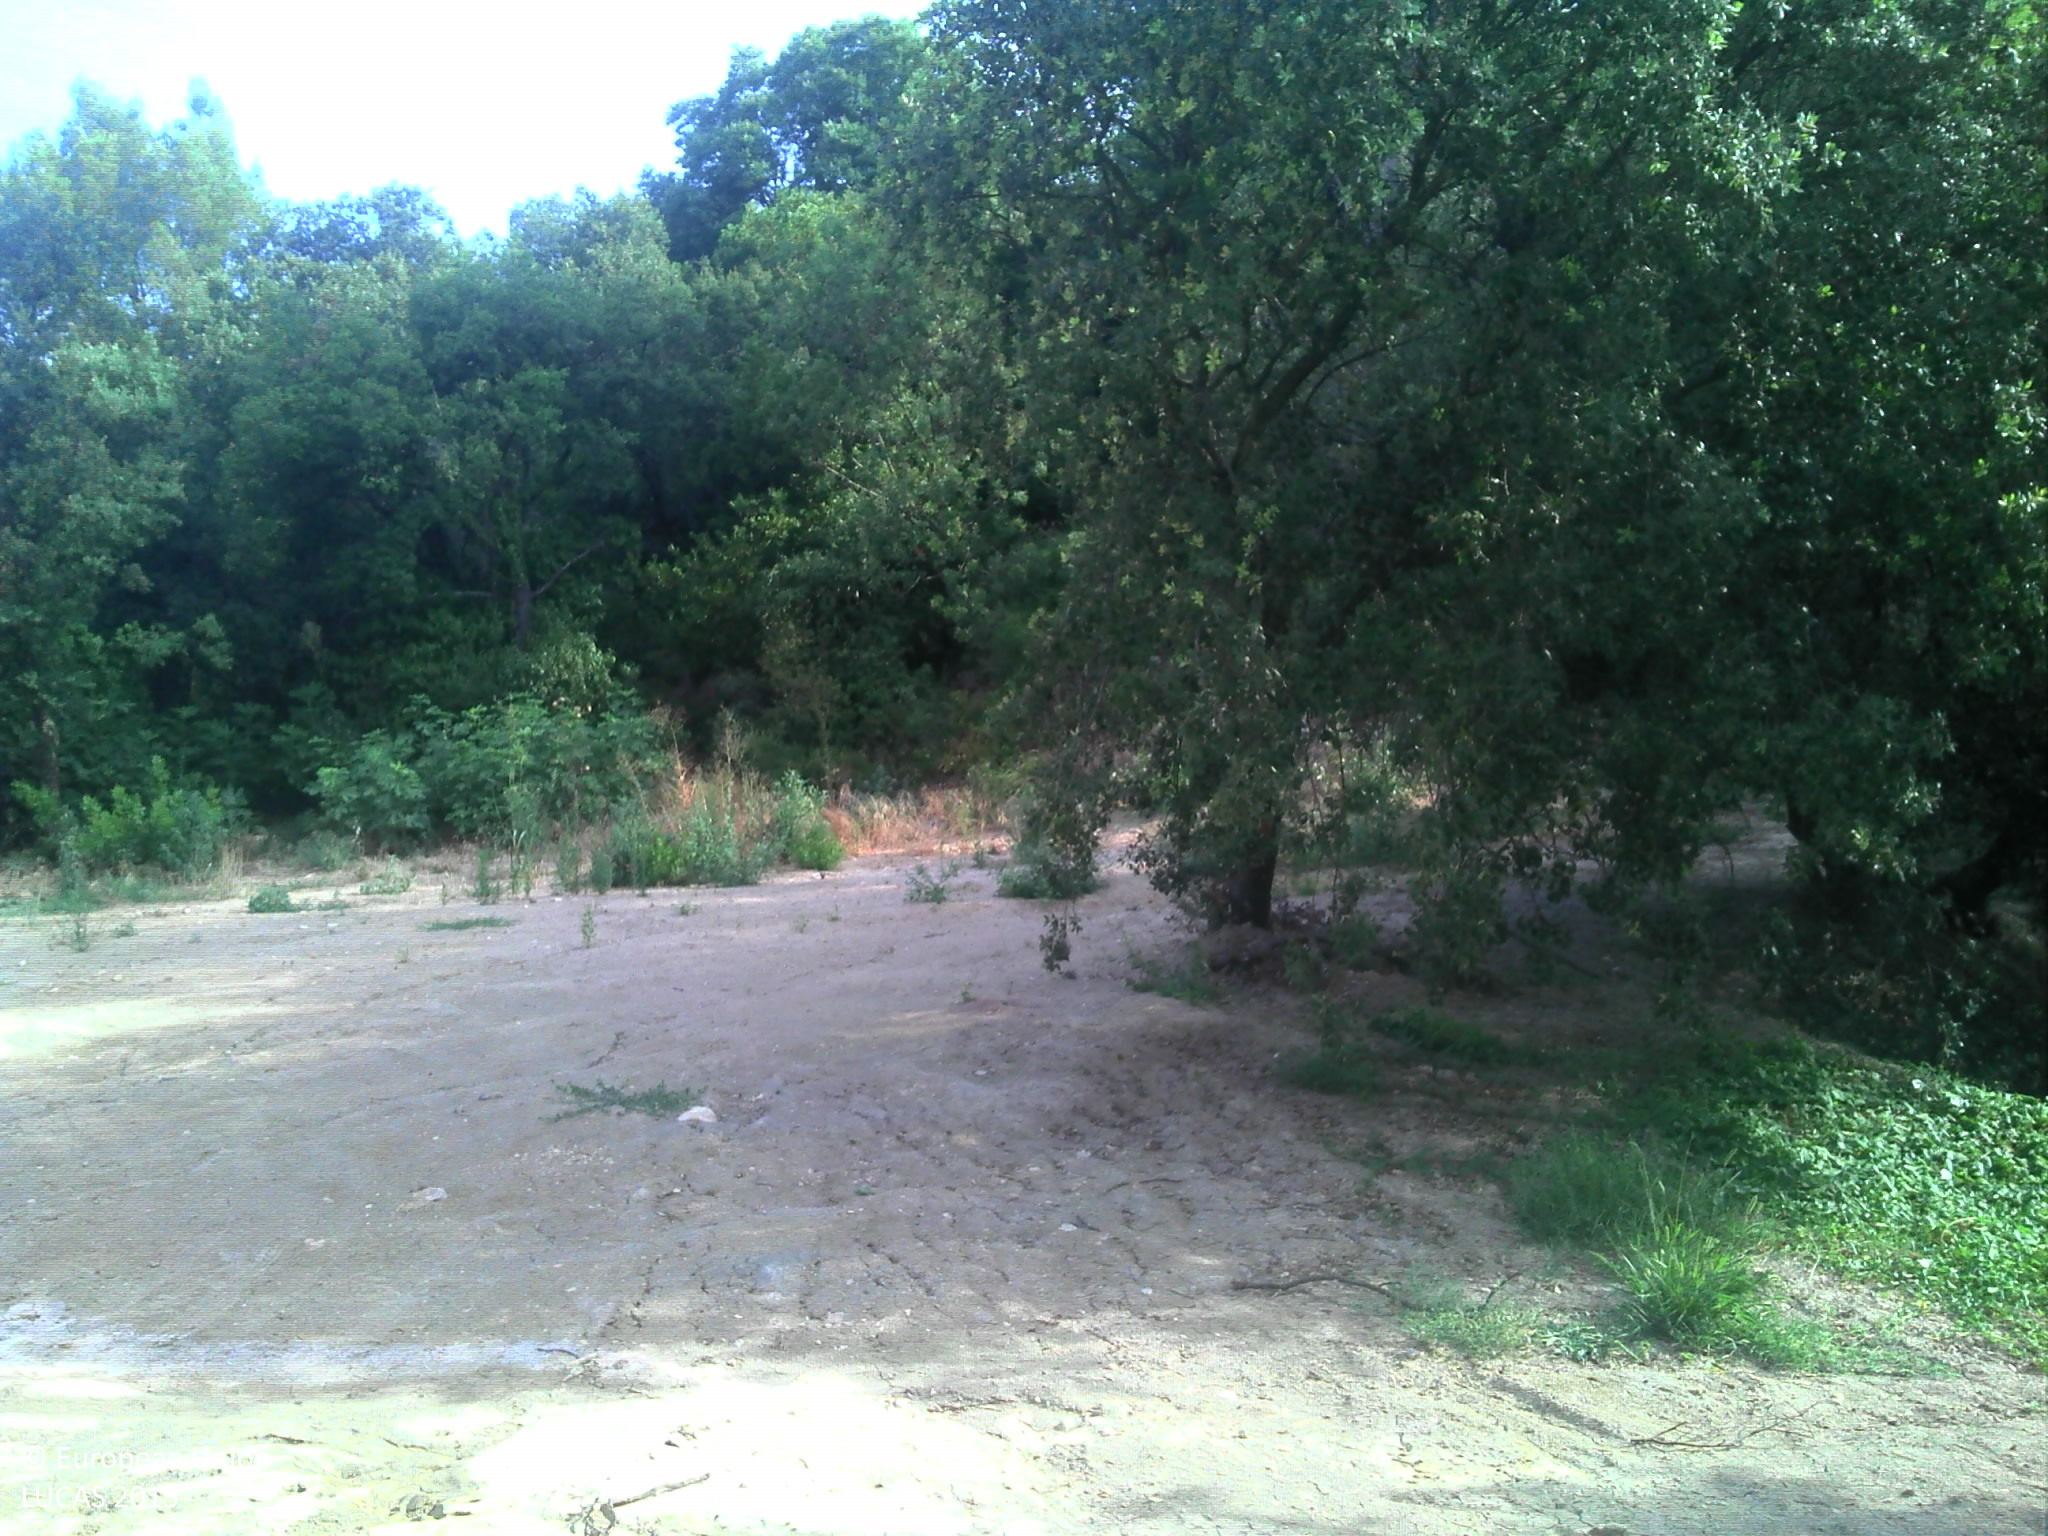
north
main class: Woodland
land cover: Broadleaved woodland
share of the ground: > 75 %
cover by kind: broadleaved forest trees 80 %
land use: Semi-natural and natural areas not in use
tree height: < 5 m
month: July
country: FR
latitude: 43.6176
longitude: 5.0406
